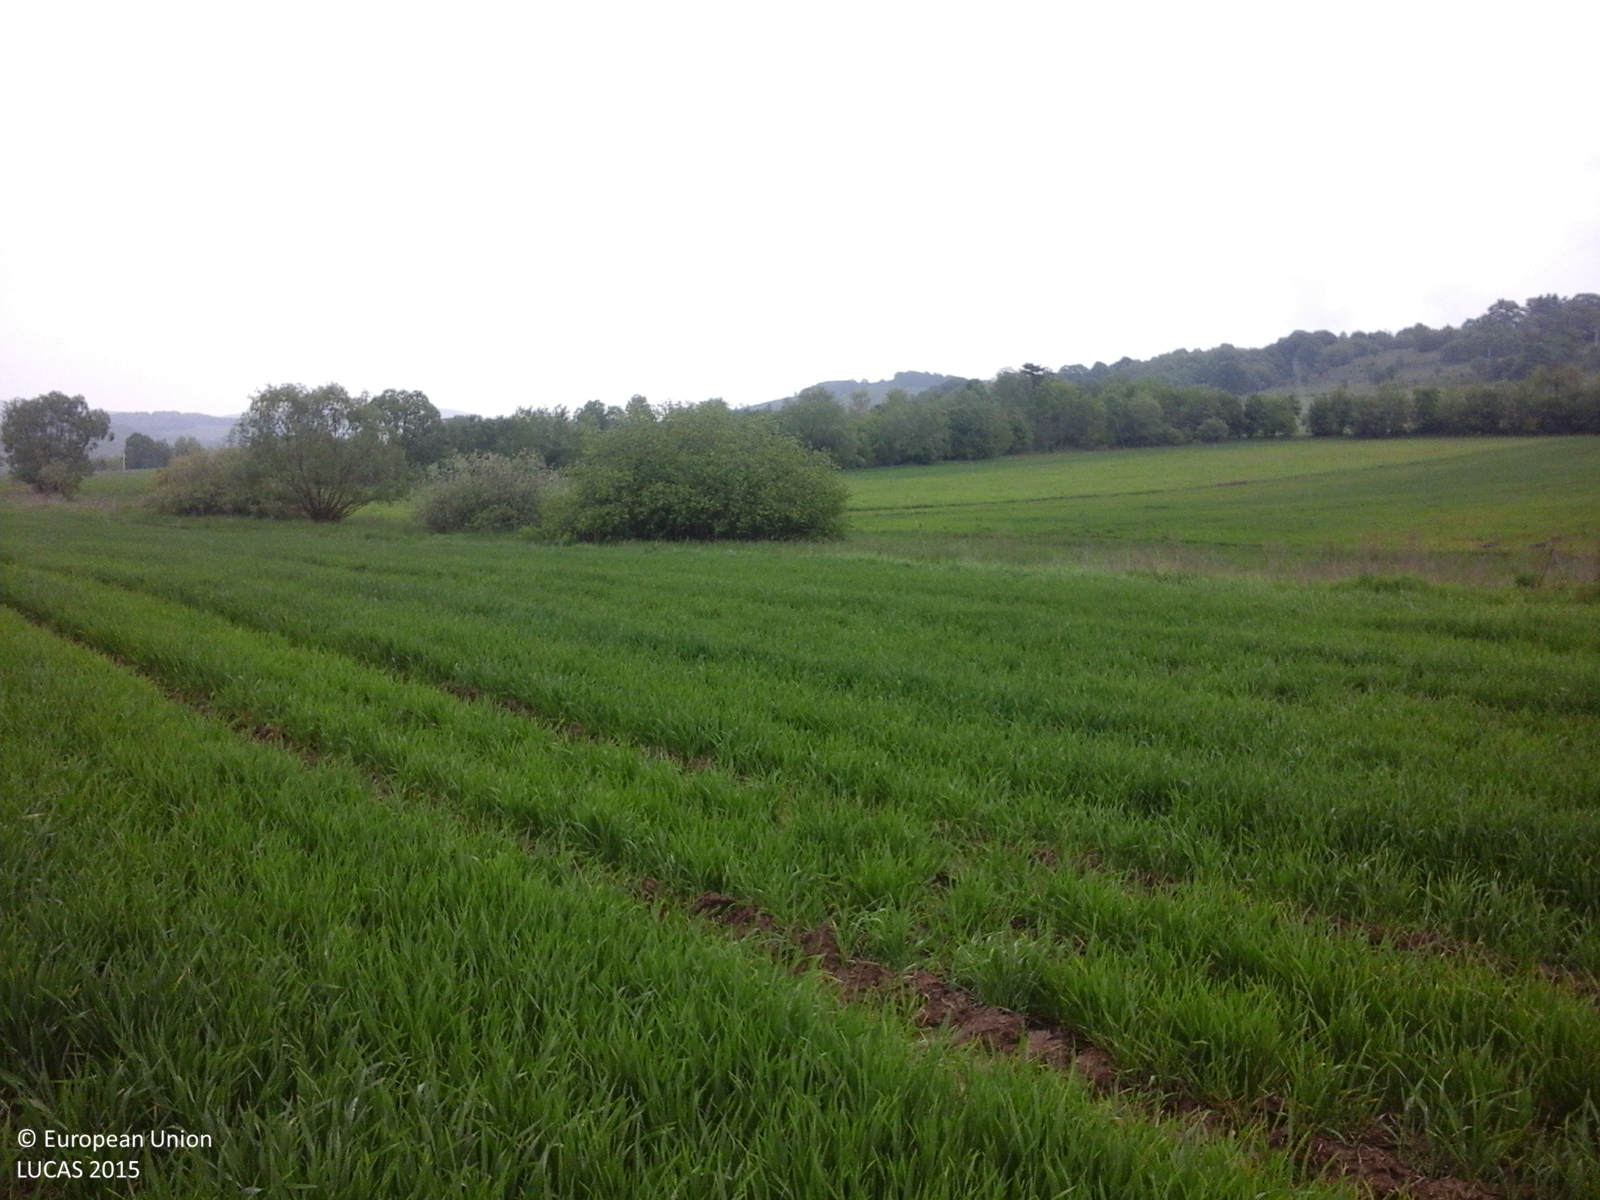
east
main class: Cropland
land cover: Common wheat
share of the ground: > 75 %
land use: Agriculture (excluding fallow land and kitchen gardens)
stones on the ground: < 10 %
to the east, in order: Common wheat; Grass margins; Tracks; Grass margins; Lines of trees; Ditches and canals; Grassland without tree/shrub cover; Common wheat; Grassland without tree/shrub cover; Common wheat; Grass margins; Ditches and canals; Lines of trees; Grass margins; Common wheat
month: May
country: RO
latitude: 45.9652
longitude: 25.3675
